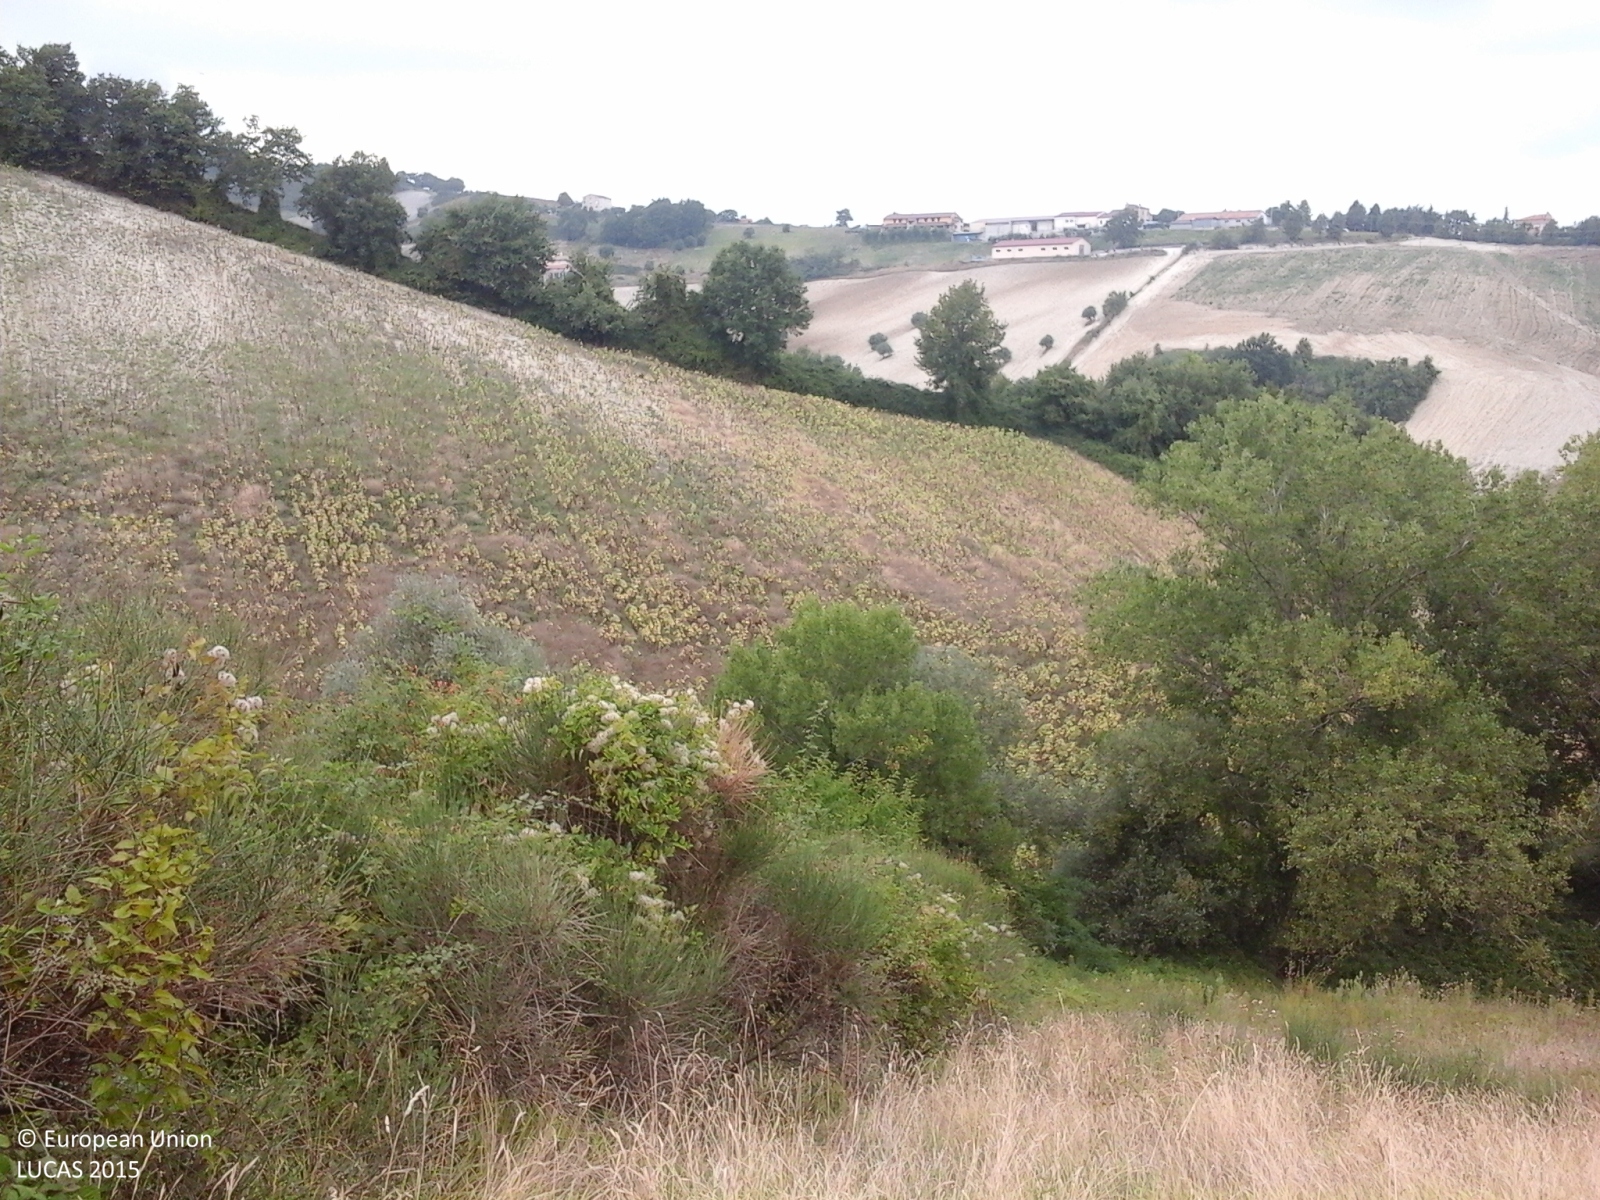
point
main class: Cropland
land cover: Sunflower
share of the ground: 25 - 50 %
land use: Agriculture (excluding fallow land and kitchen gardens)
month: August
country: IT
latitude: 43.4176
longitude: 13.1661
